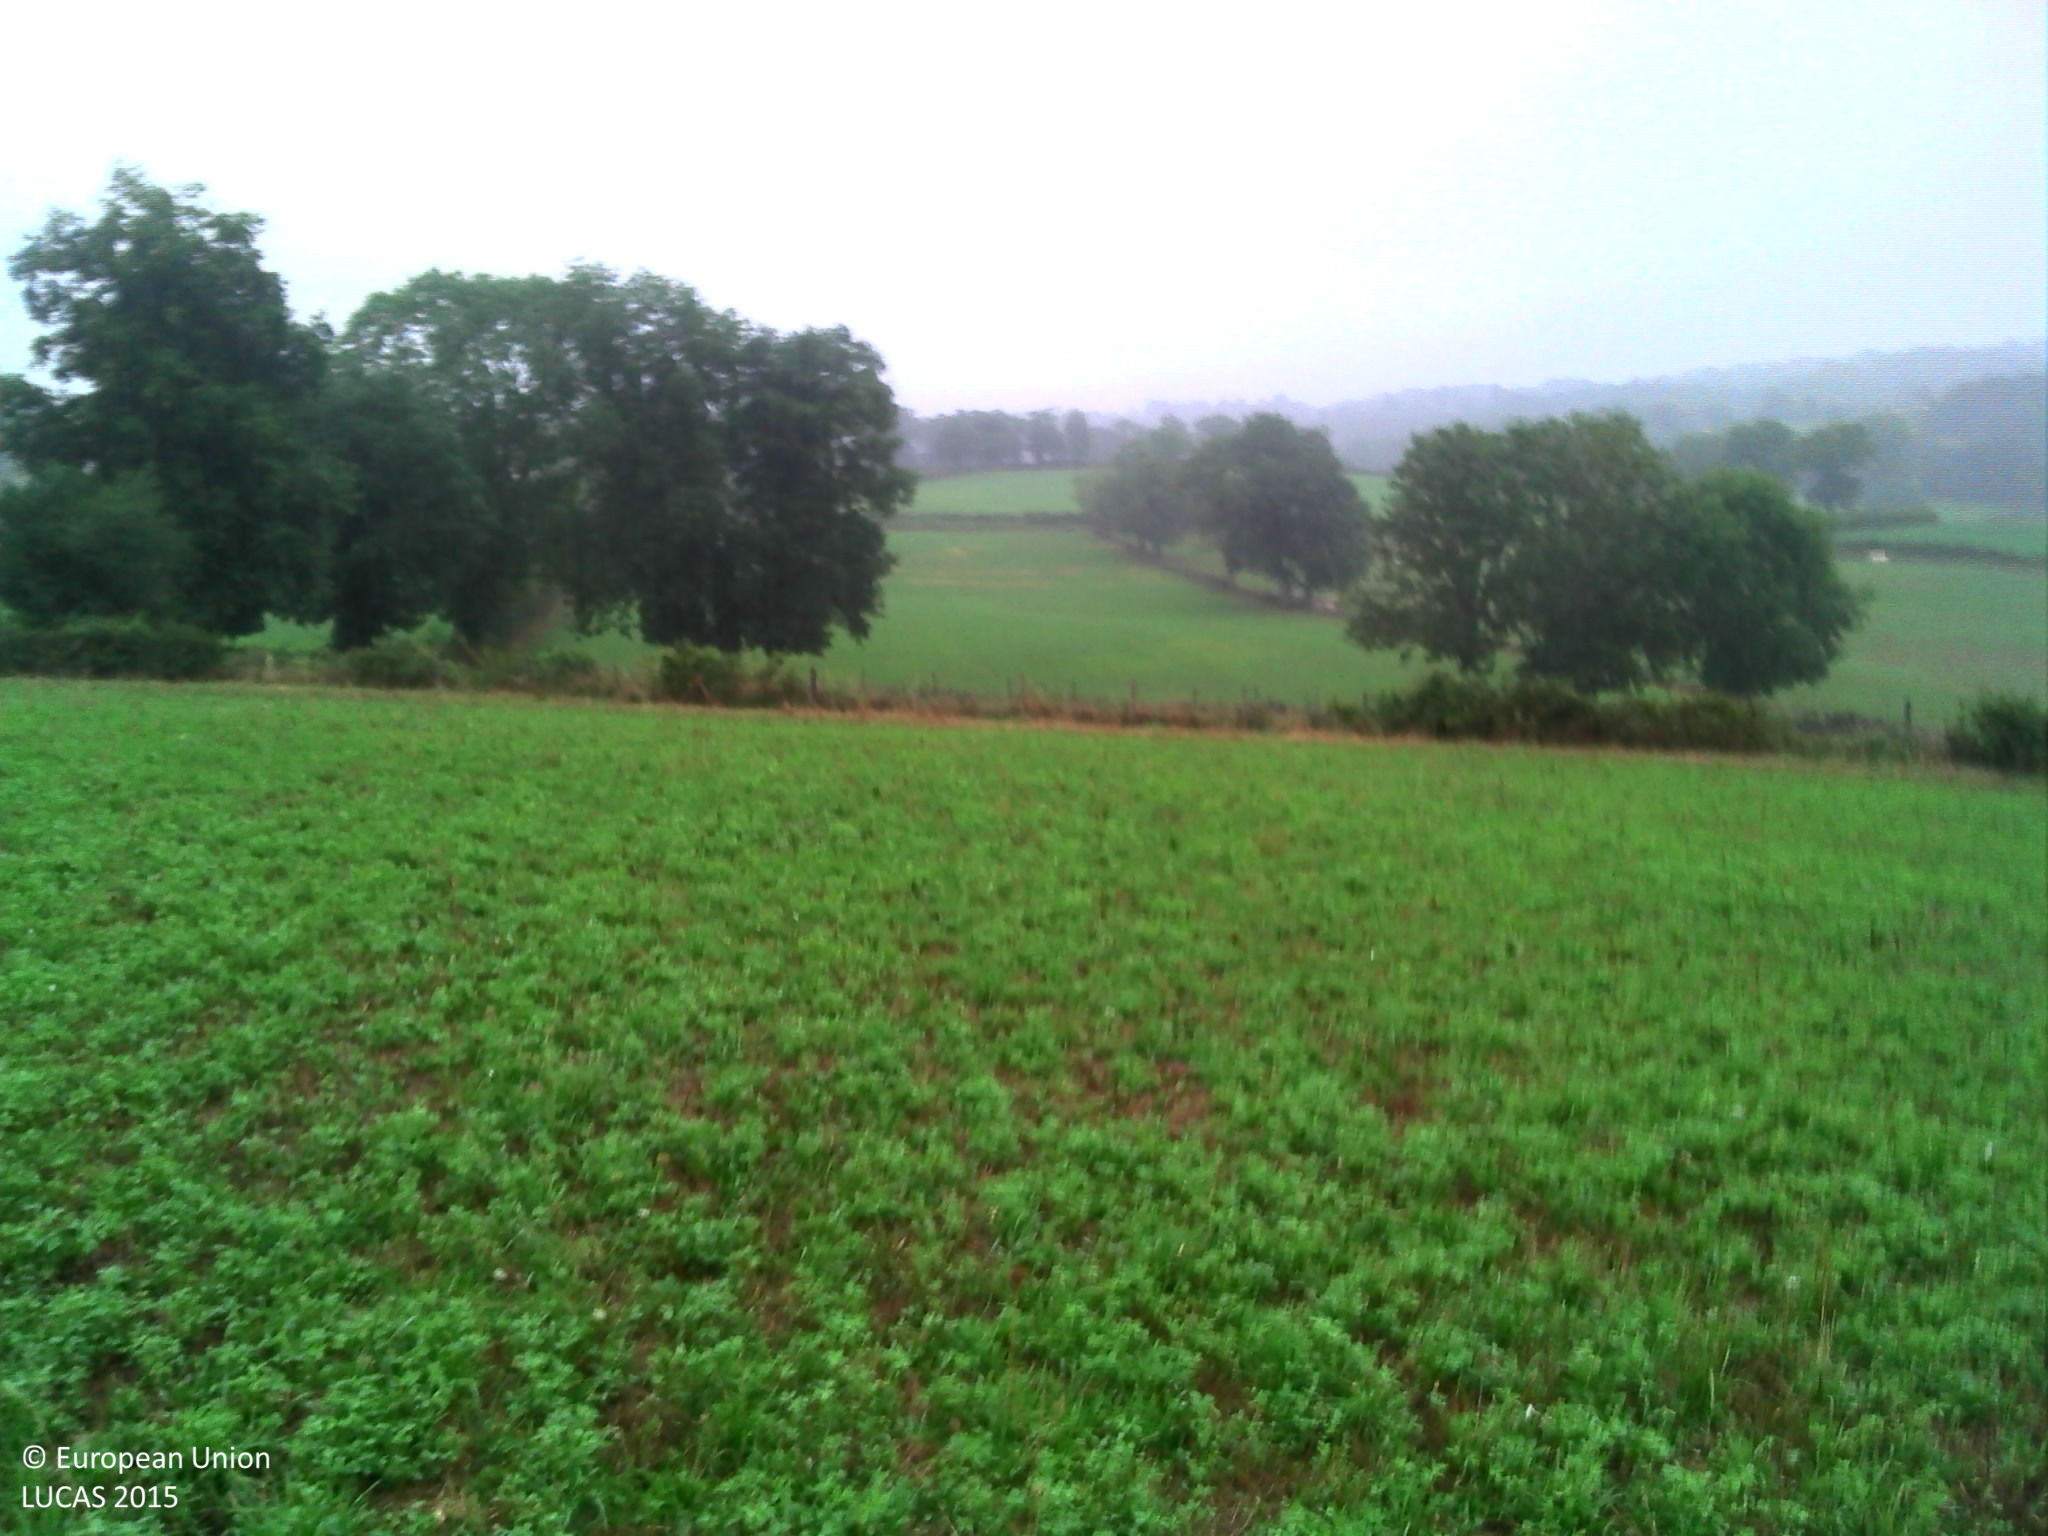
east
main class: Cropland
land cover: Lucerne
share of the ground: > 75 %
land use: Agriculture (excluding fallow land and kitchen gardens)
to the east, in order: Lucerne; Fences; Shruby margins; Tracks; Shruby margins; Dry stone walls; Fences; Grassland without tree/shrub cover; Fences; Dry stone walls; Shruby margins; Grassland without tree/shrub cover; Dry stone walls; Fences; Single bushes/trees; Fences; Grassland without tree/shrub cover
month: August
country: FR
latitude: 46.0754
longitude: 2.3282
